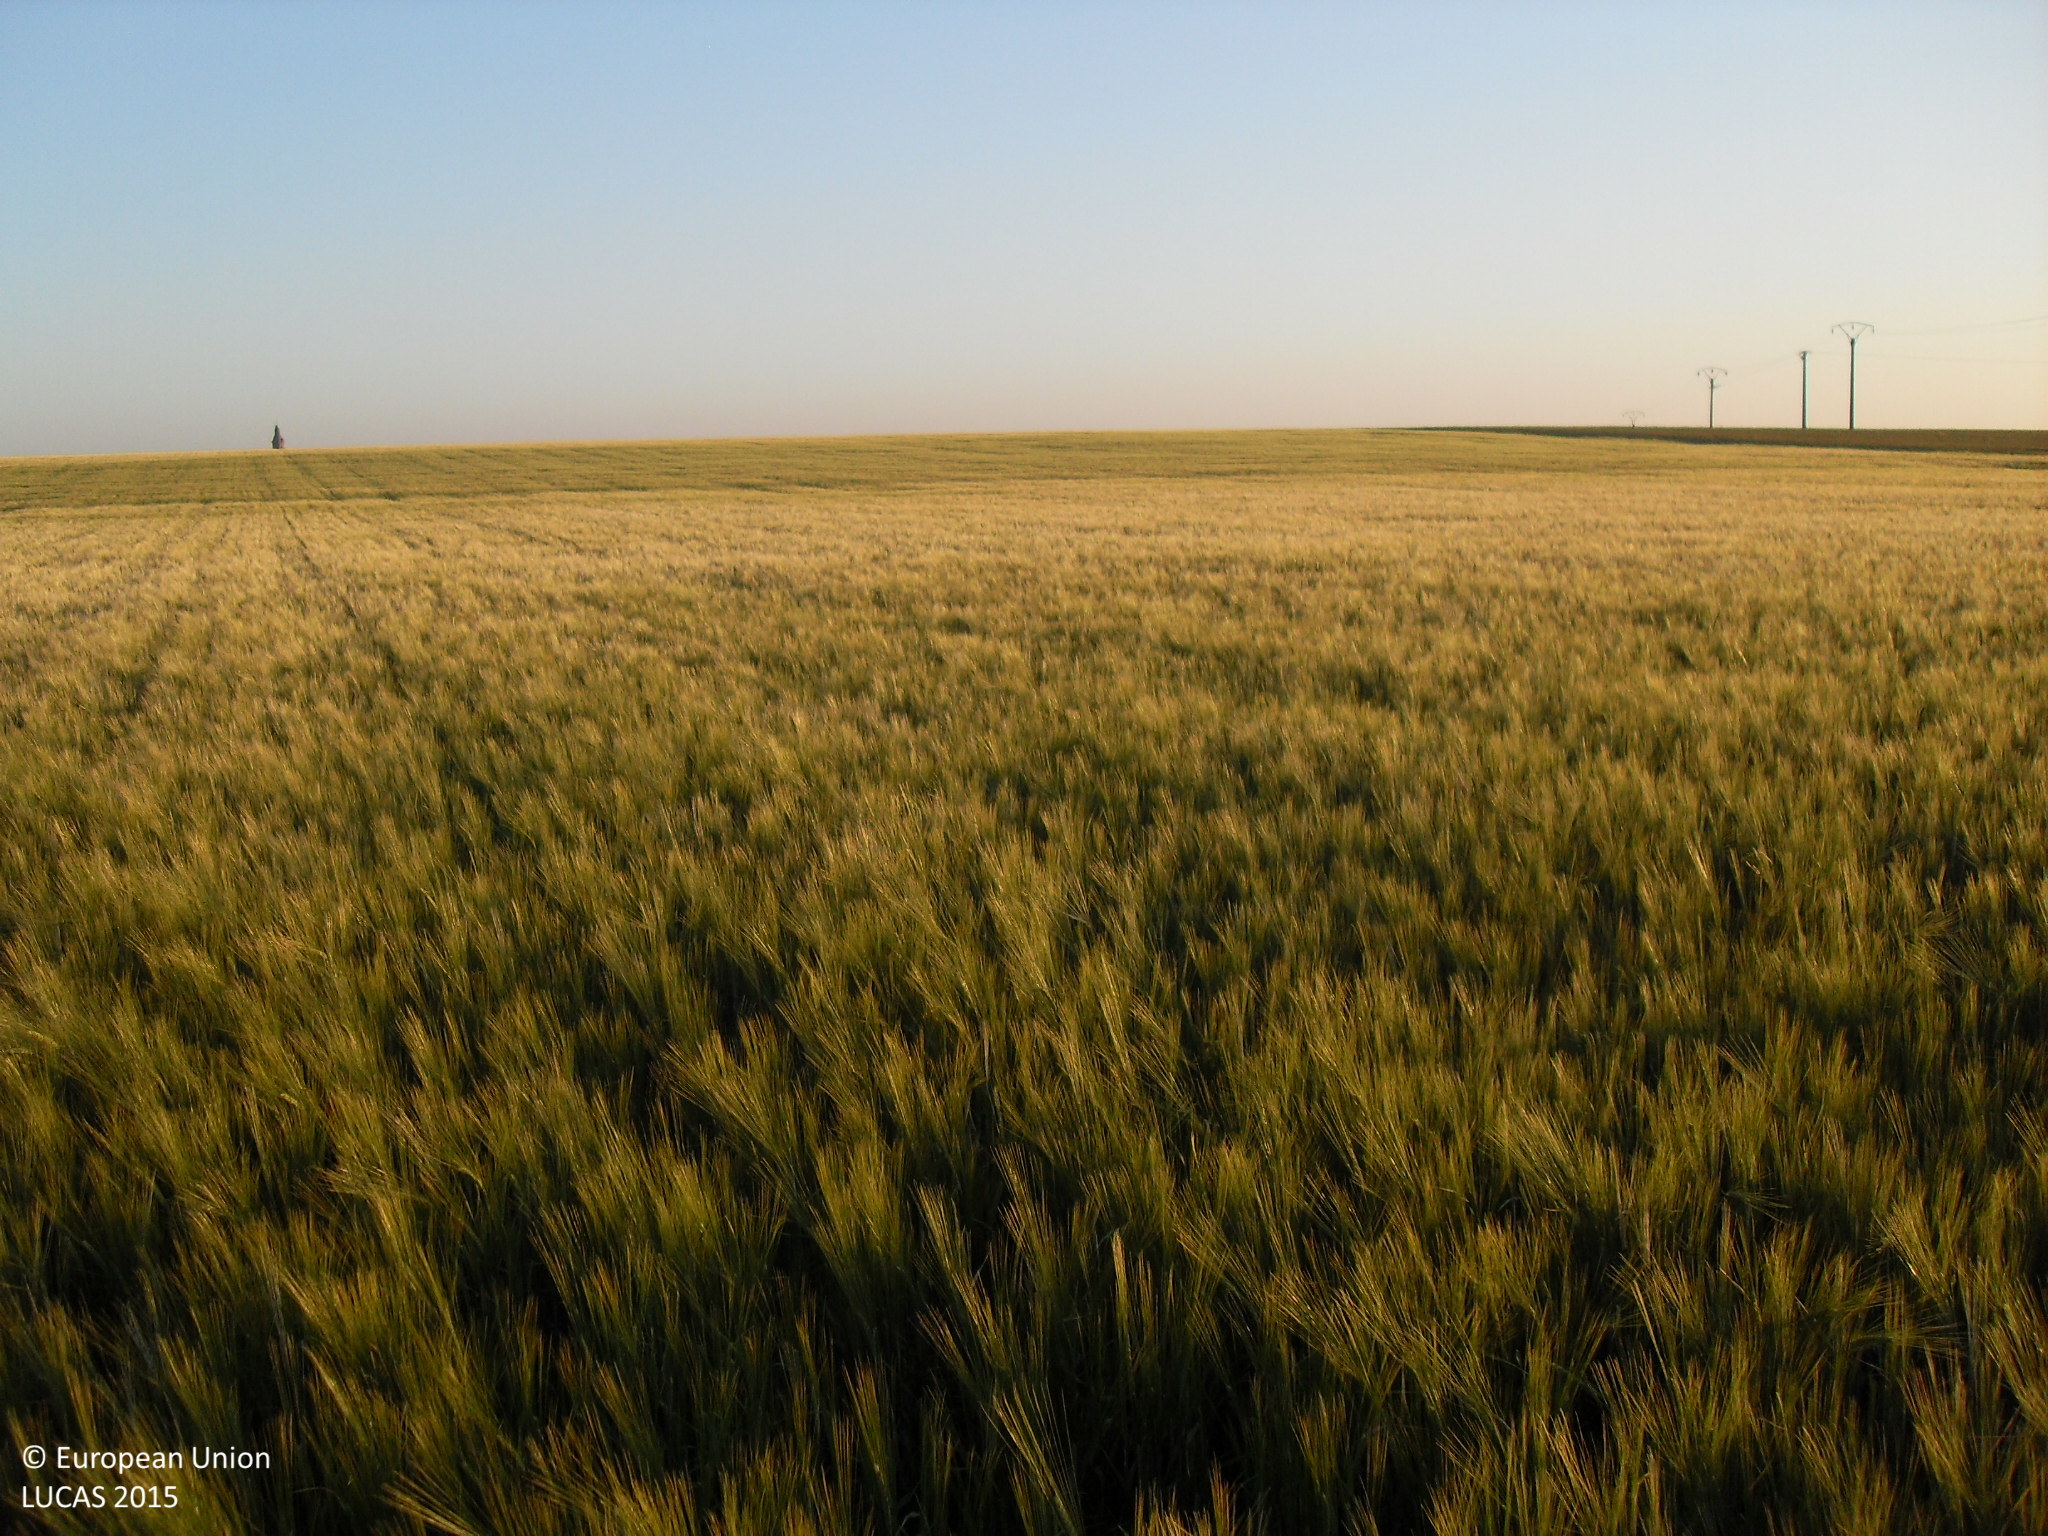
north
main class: Cropland
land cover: Barley
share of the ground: > 75 %
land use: Agriculture (excluding fallow land and kitchen gardens)
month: May
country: ES
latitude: 41.0420
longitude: -5.1892
